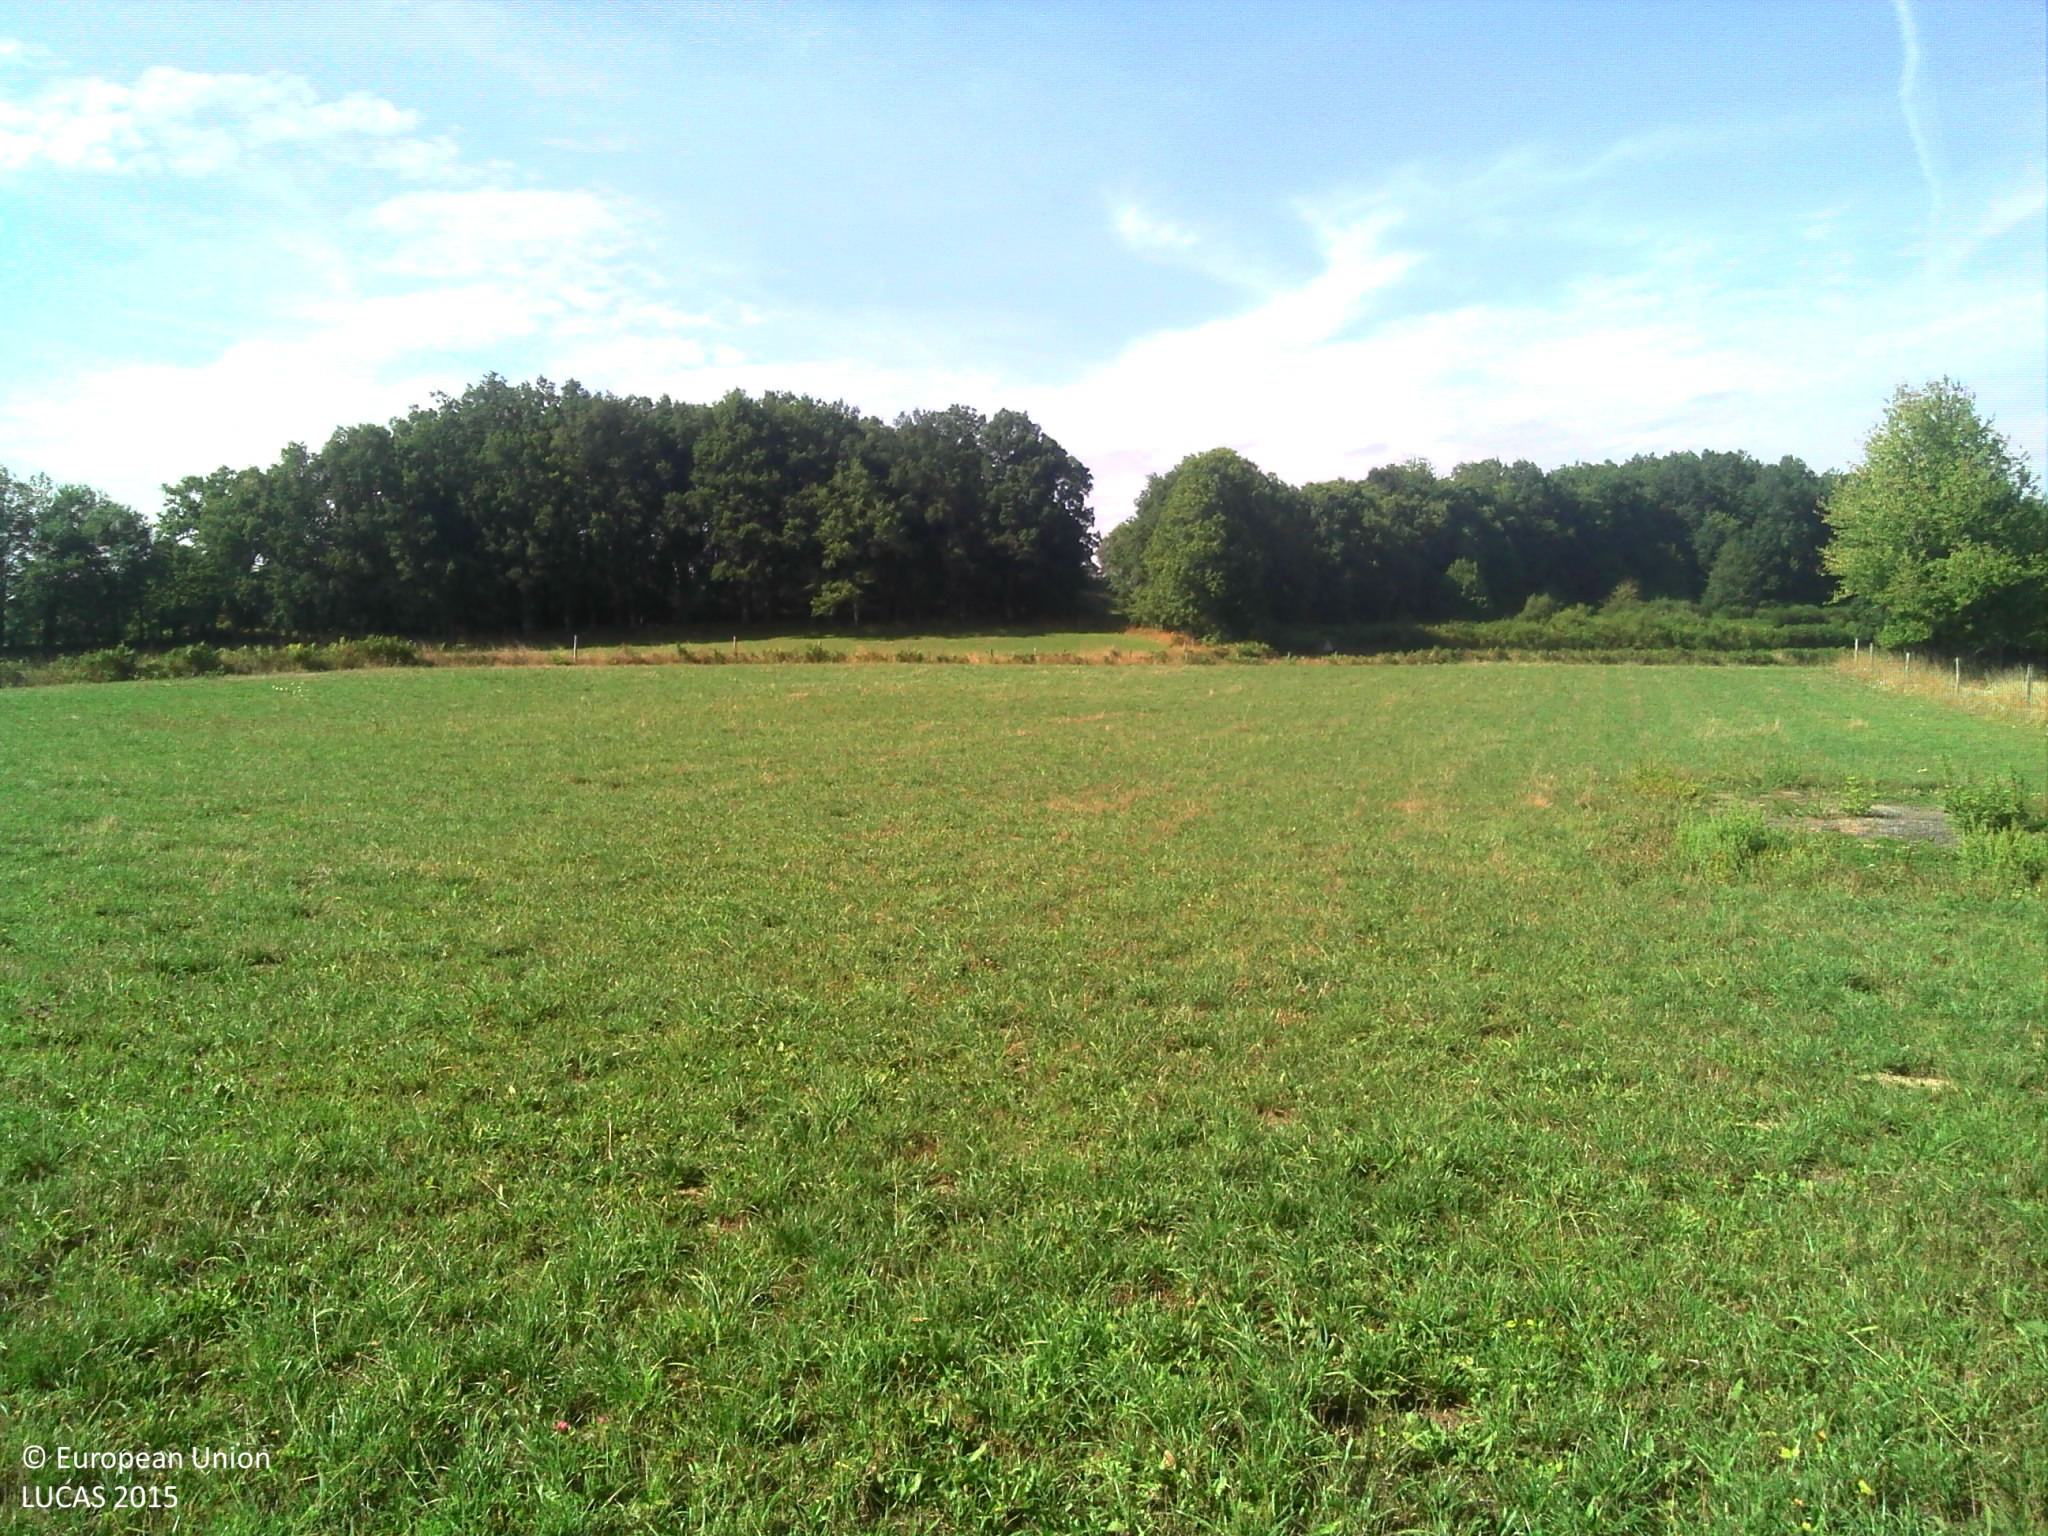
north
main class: Grassland
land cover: Grassland without tree/shrub cover
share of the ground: > 75 %
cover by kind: herbaceous plants 100 %
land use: Agriculture (excluding fallow land and kitchen gardens)
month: August
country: FR
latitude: 46.1424
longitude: 1.7721
